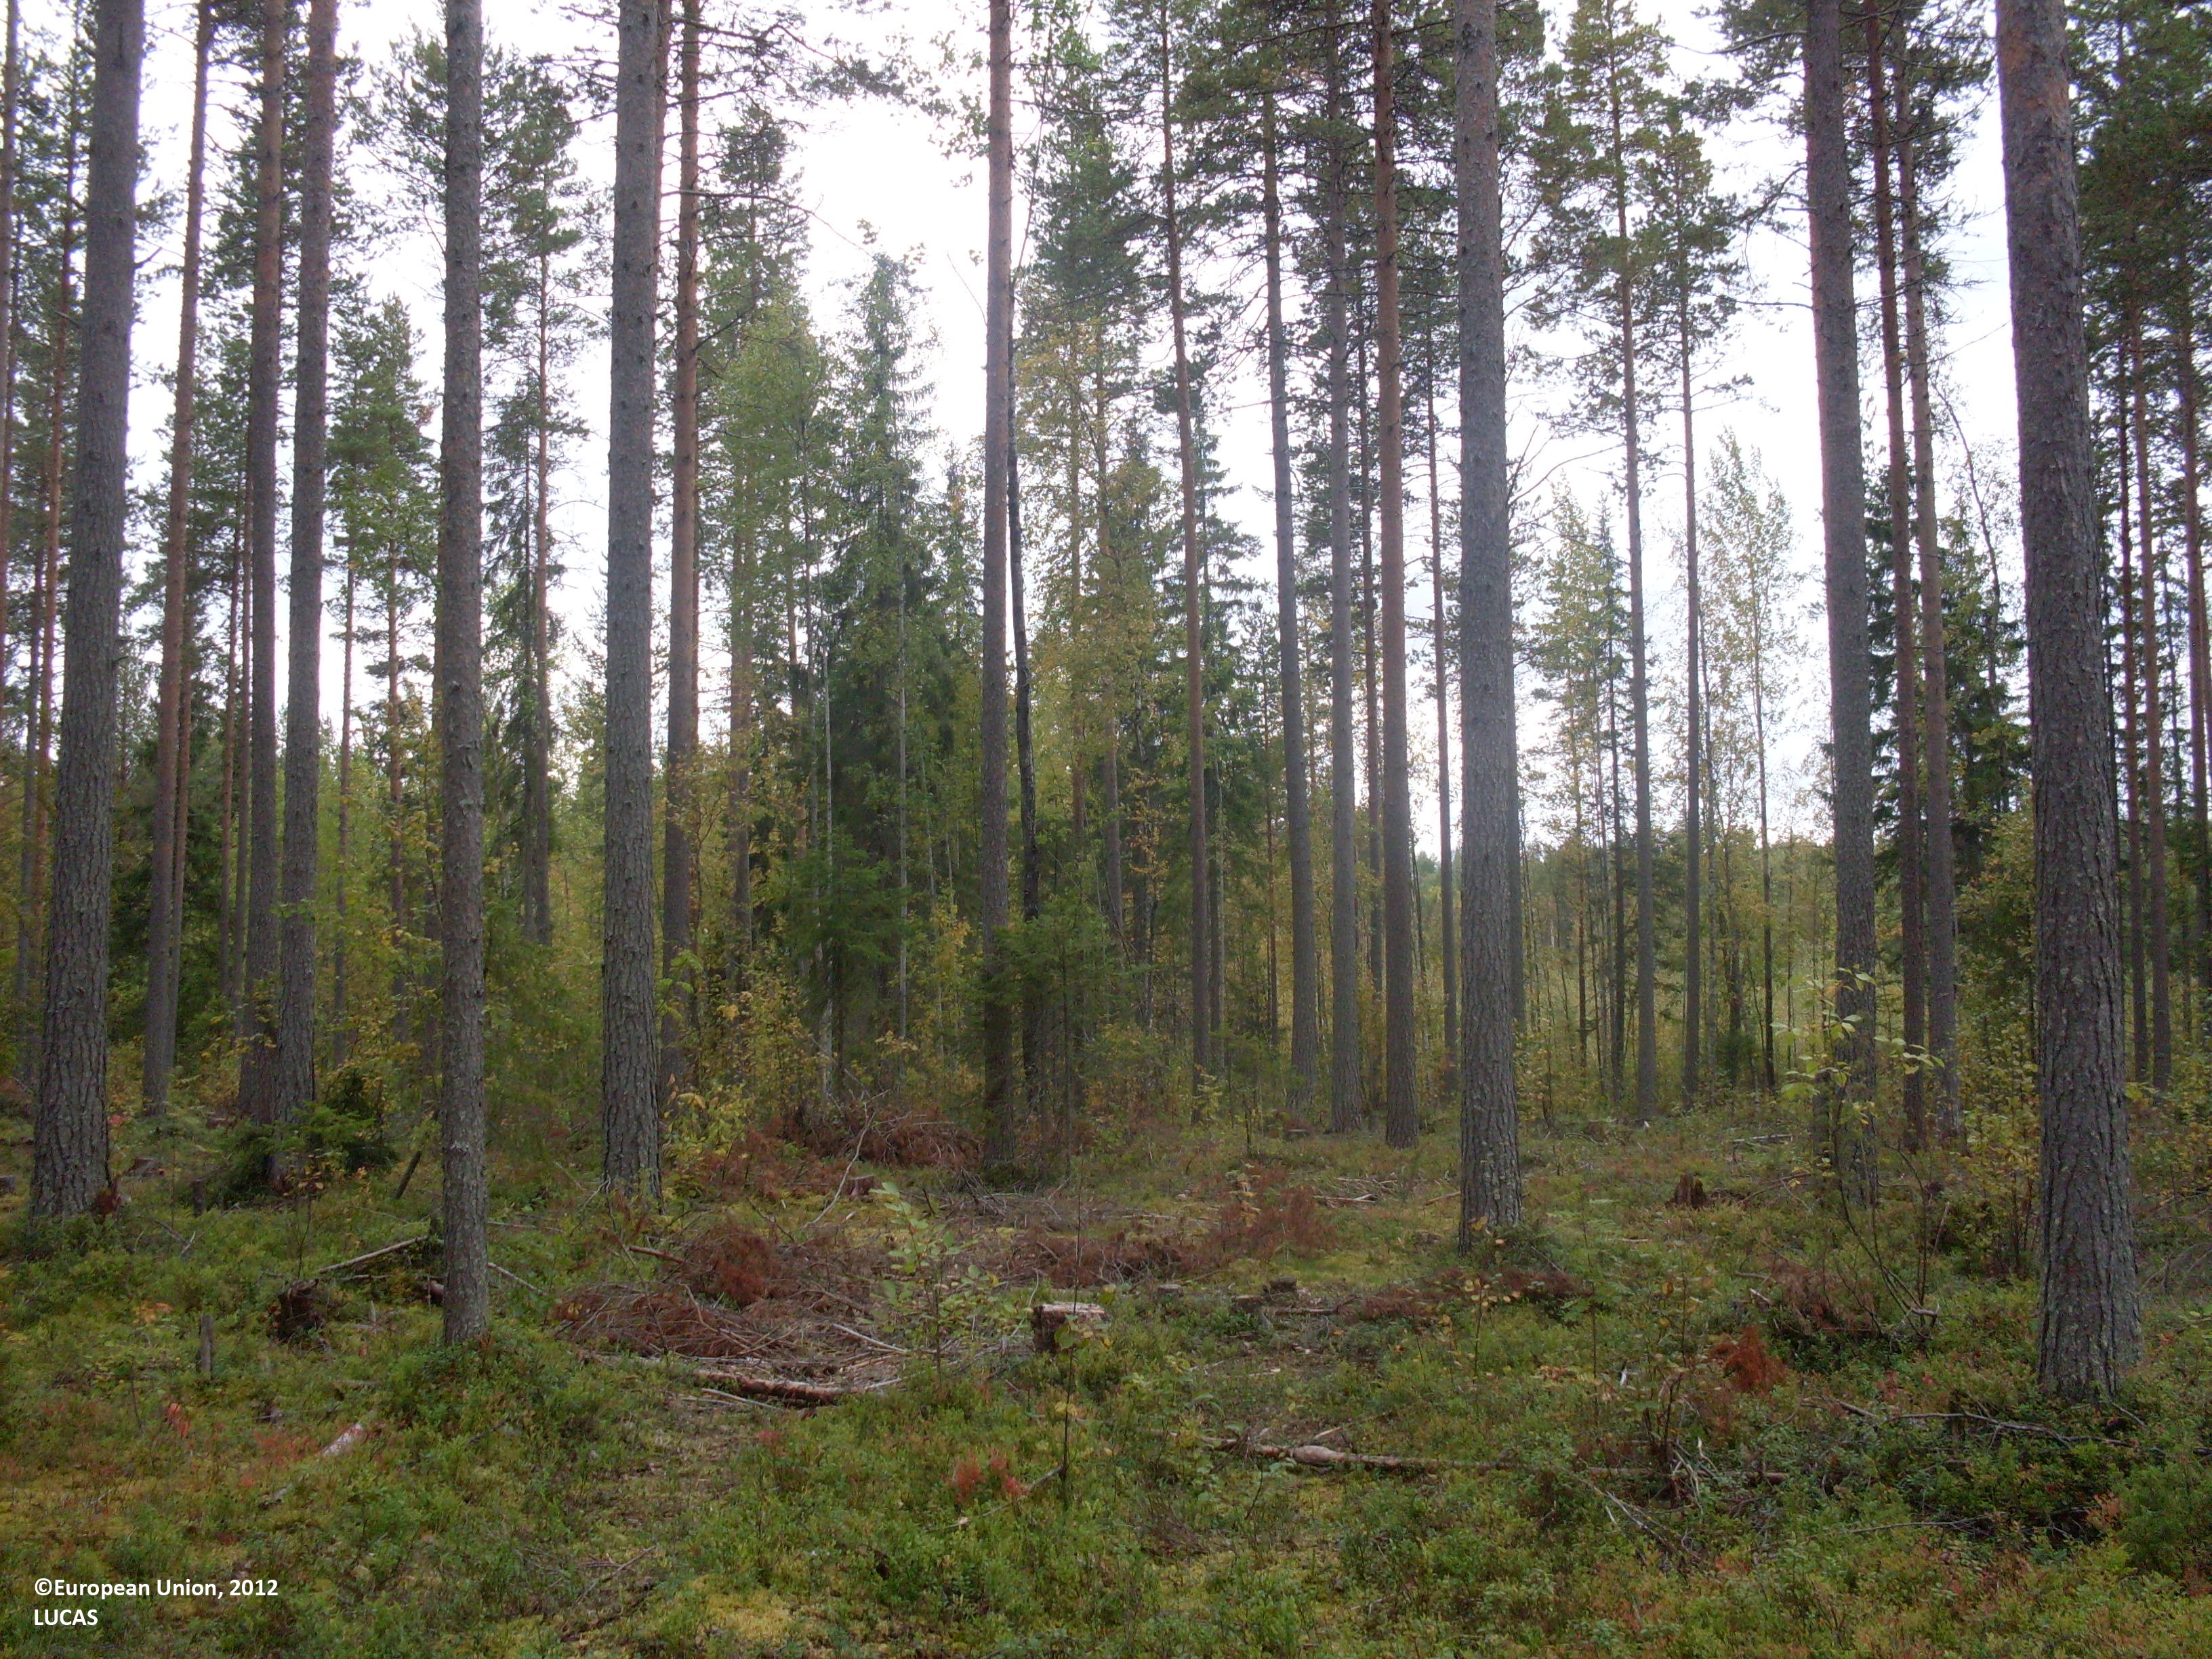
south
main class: Woodland
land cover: Other mixed woodland
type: boreal forest
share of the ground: 50 - 75 %
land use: Forestry
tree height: > 5 m
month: September
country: FI
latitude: 64.0811
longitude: 29.6864
